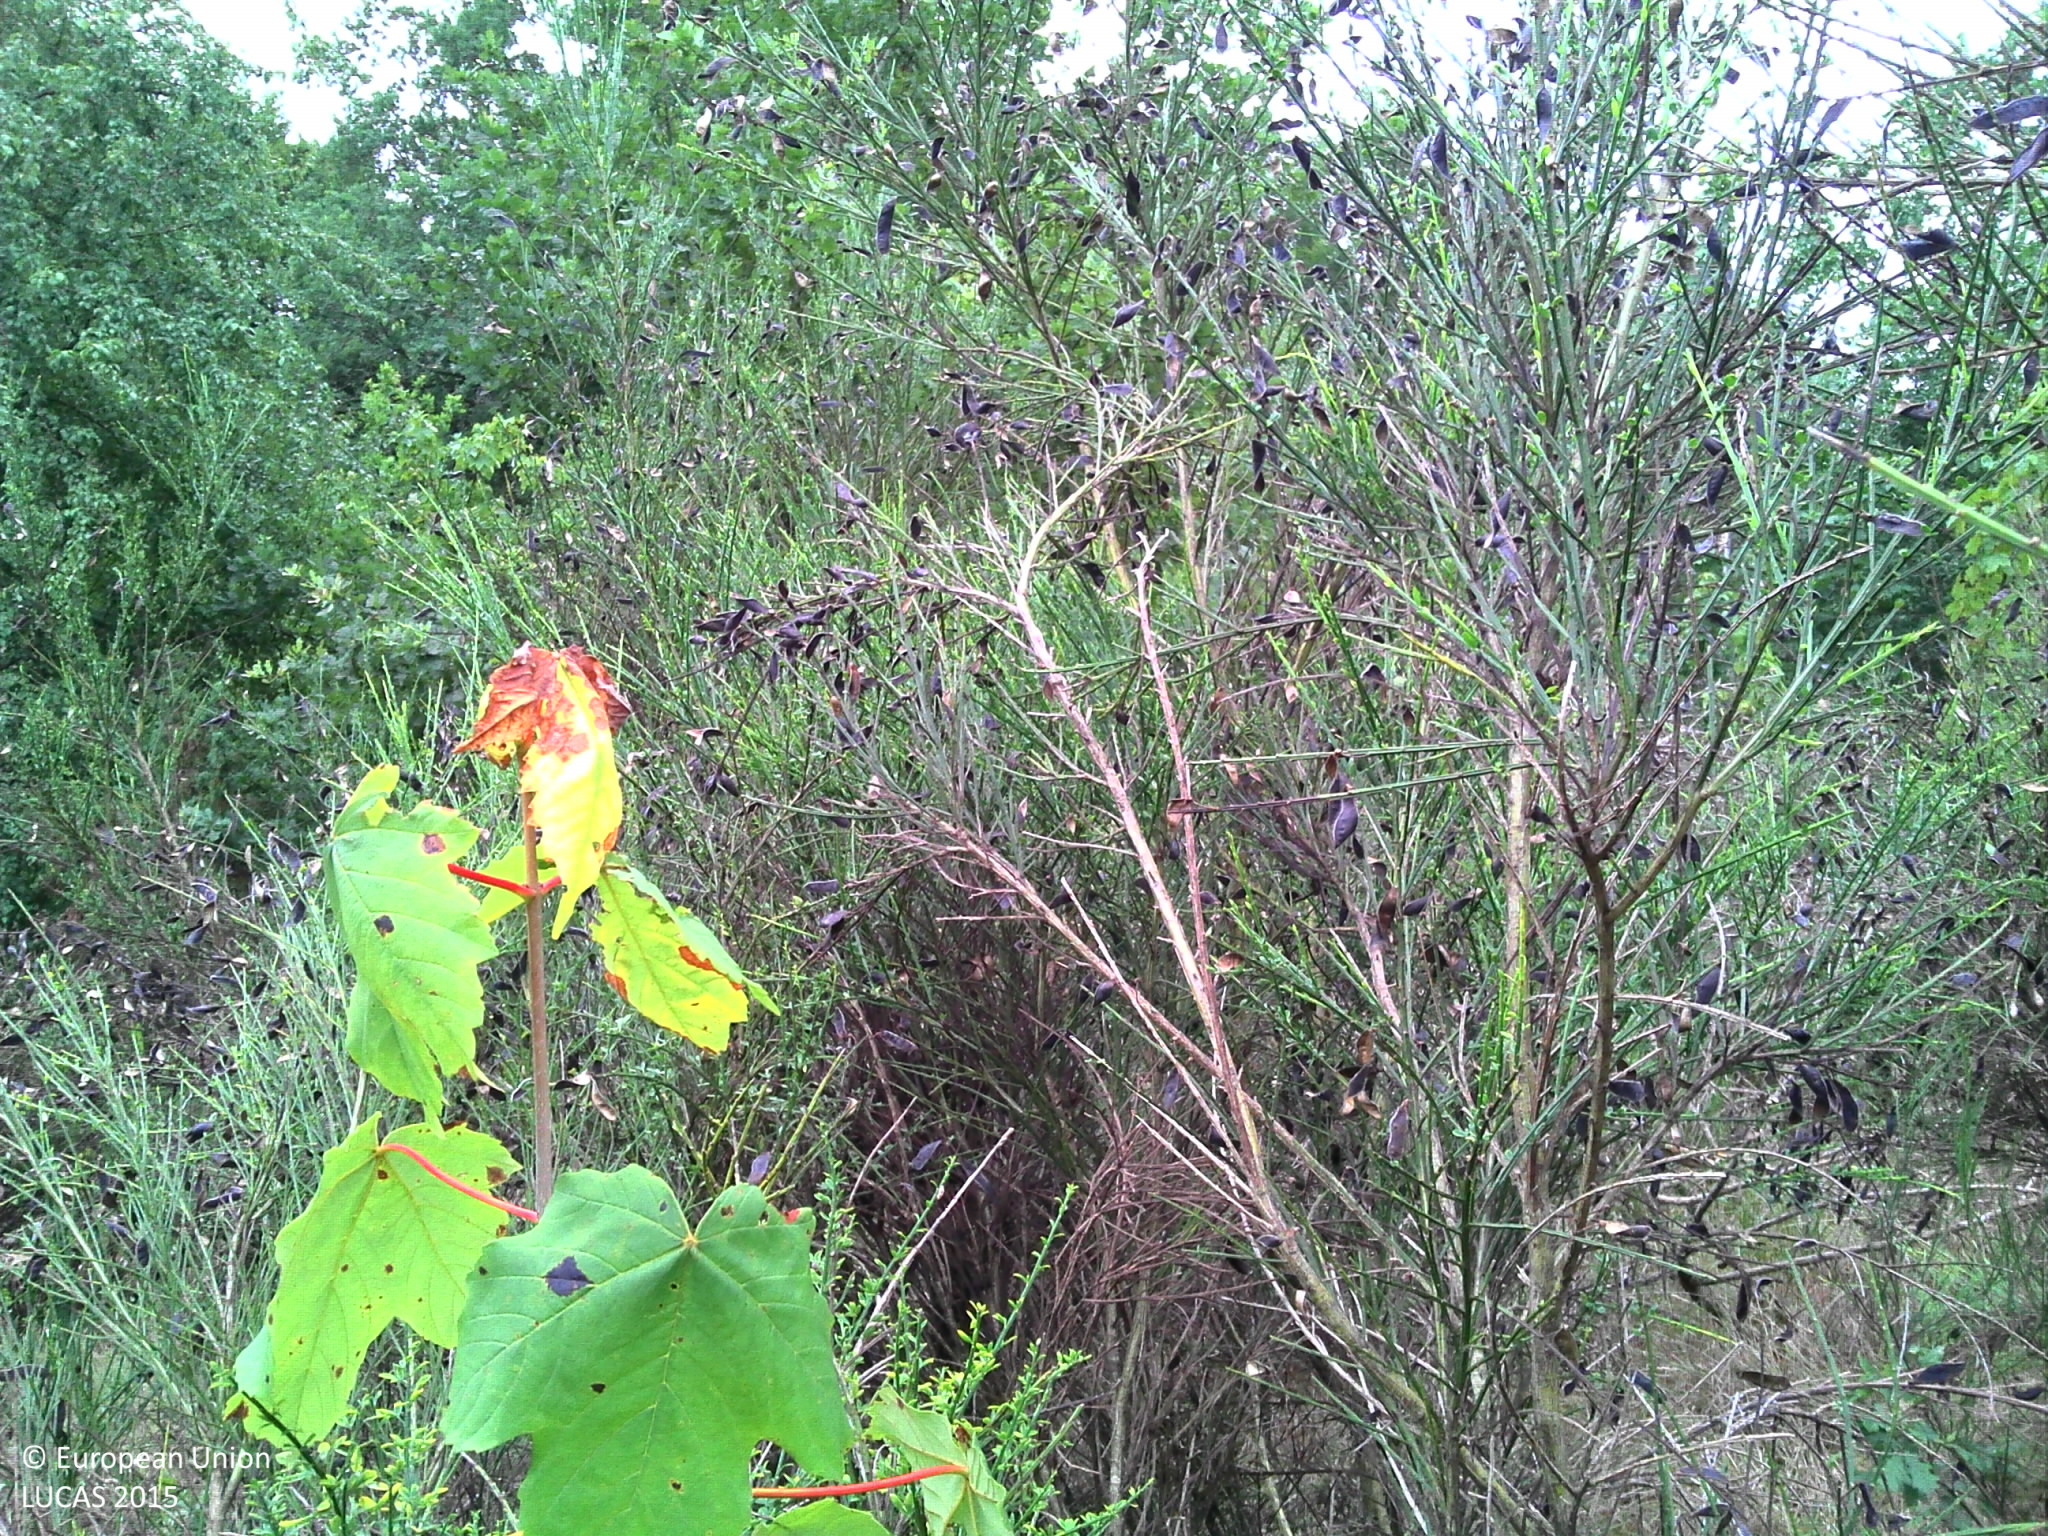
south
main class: Shrubland
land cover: Shrubland without tree cover
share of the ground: > 75 %
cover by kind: shrubs 90 %, herbaceous plants 10 %
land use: Semi-natural and natural areas not in use
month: August
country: FR
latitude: 45.4983
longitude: 1.8694
